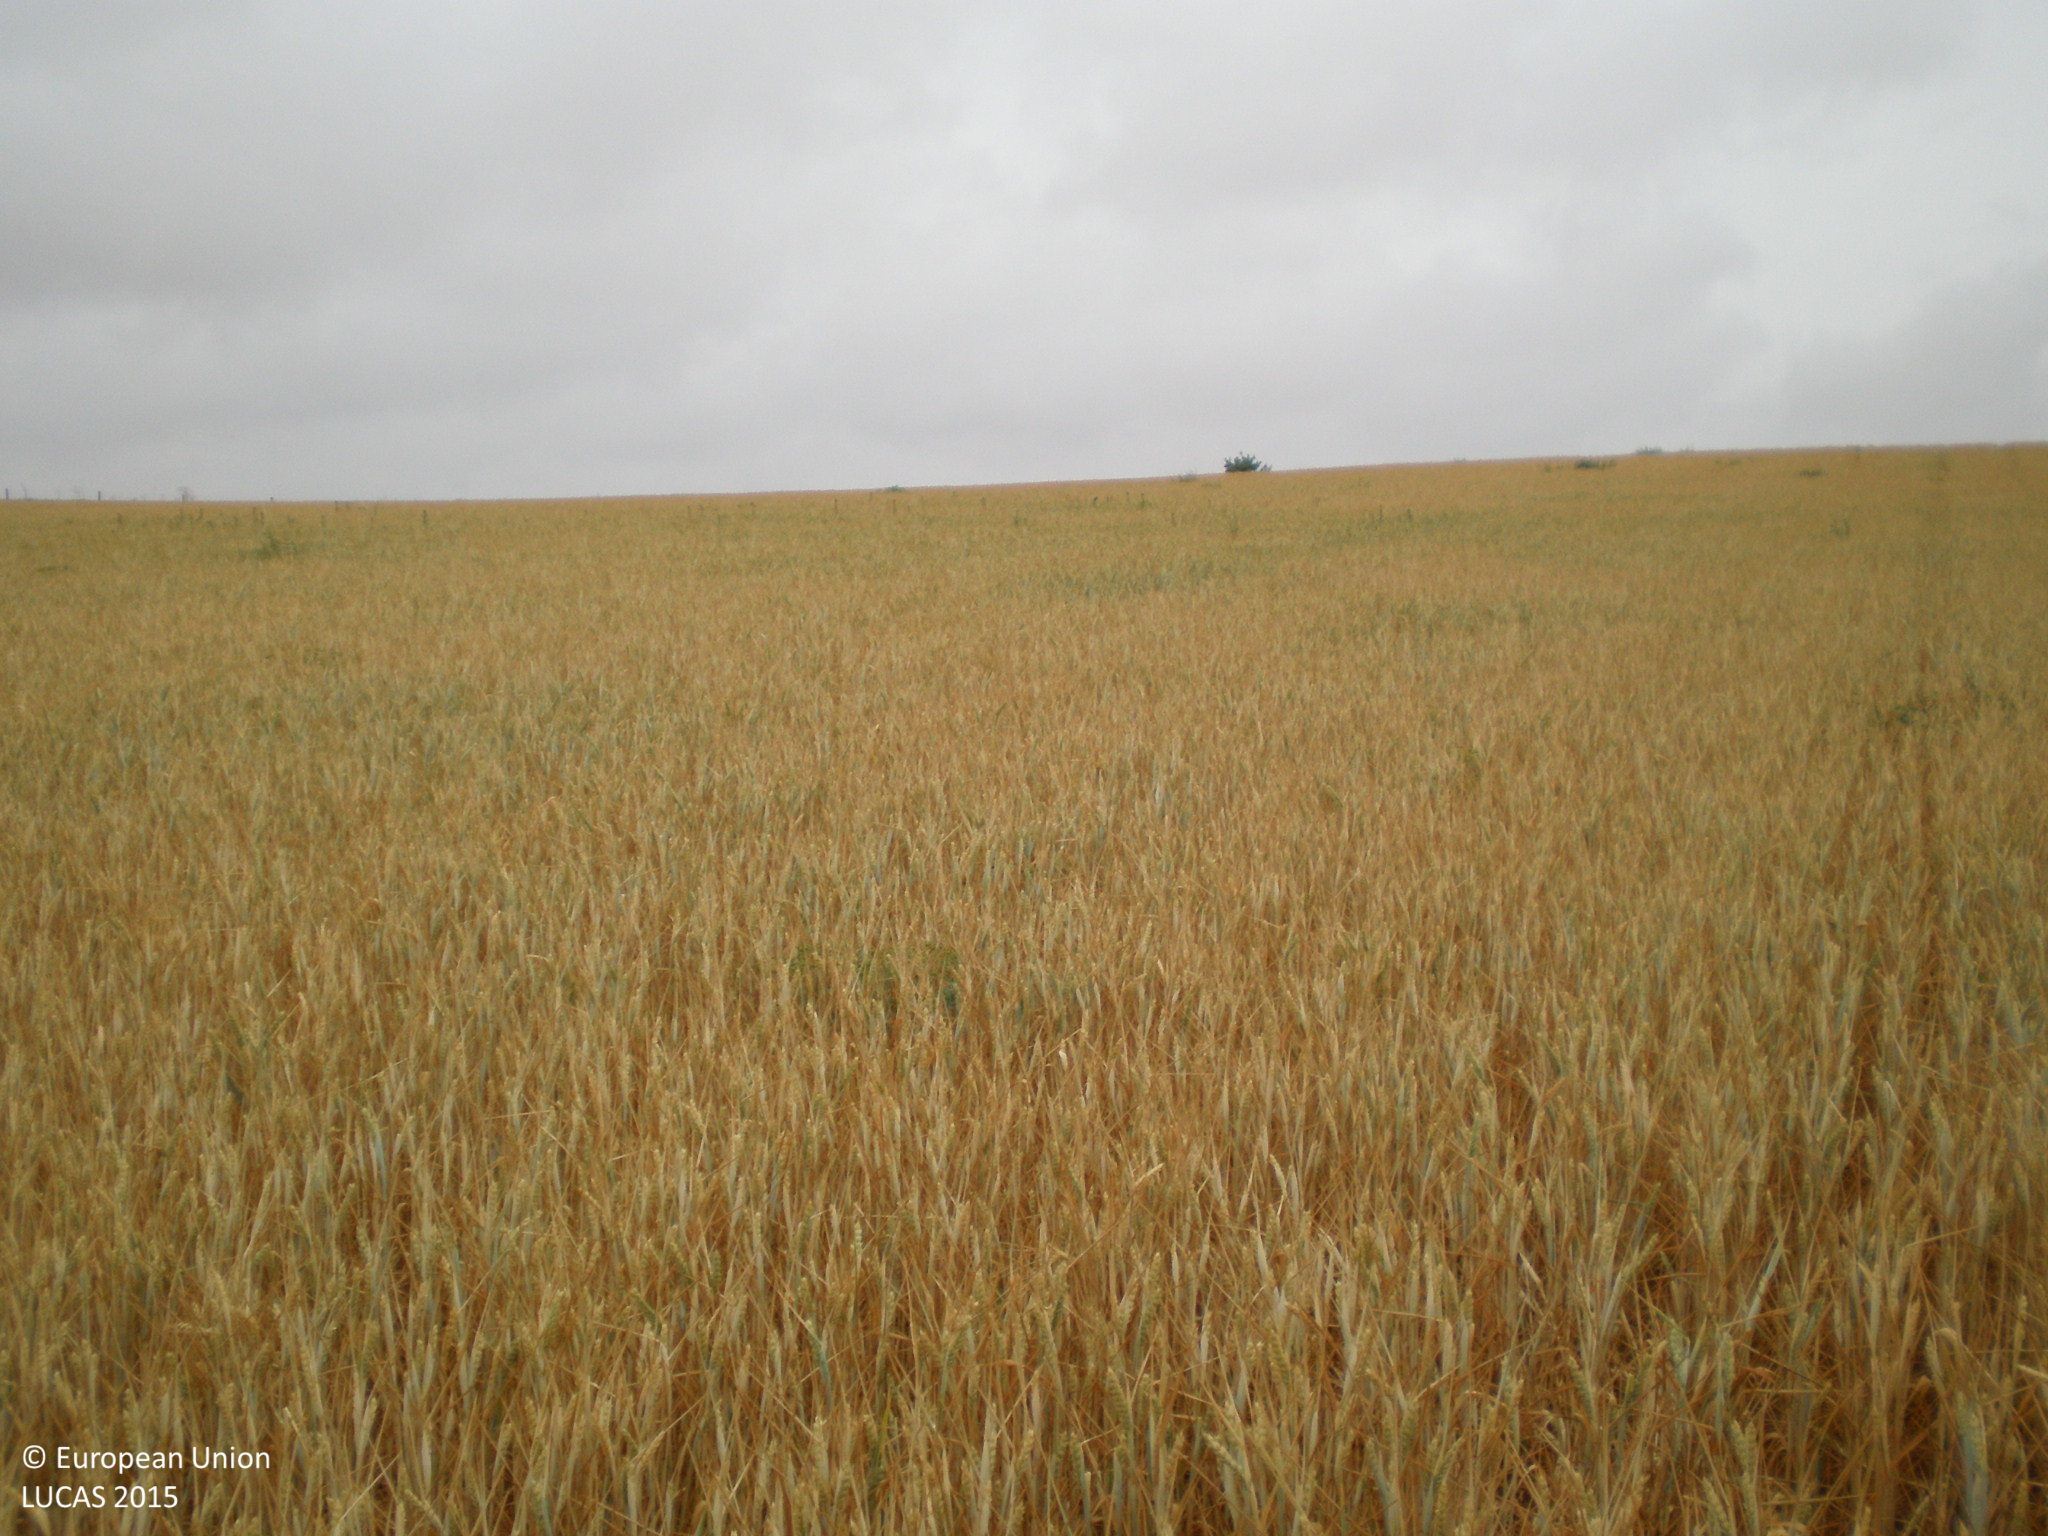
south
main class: Cropland
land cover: Common wheat
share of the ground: > 75 %
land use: Agriculture (excluding fallow land and kitchen gardens)
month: June
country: ES
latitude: 40.9714
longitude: -5.7532
